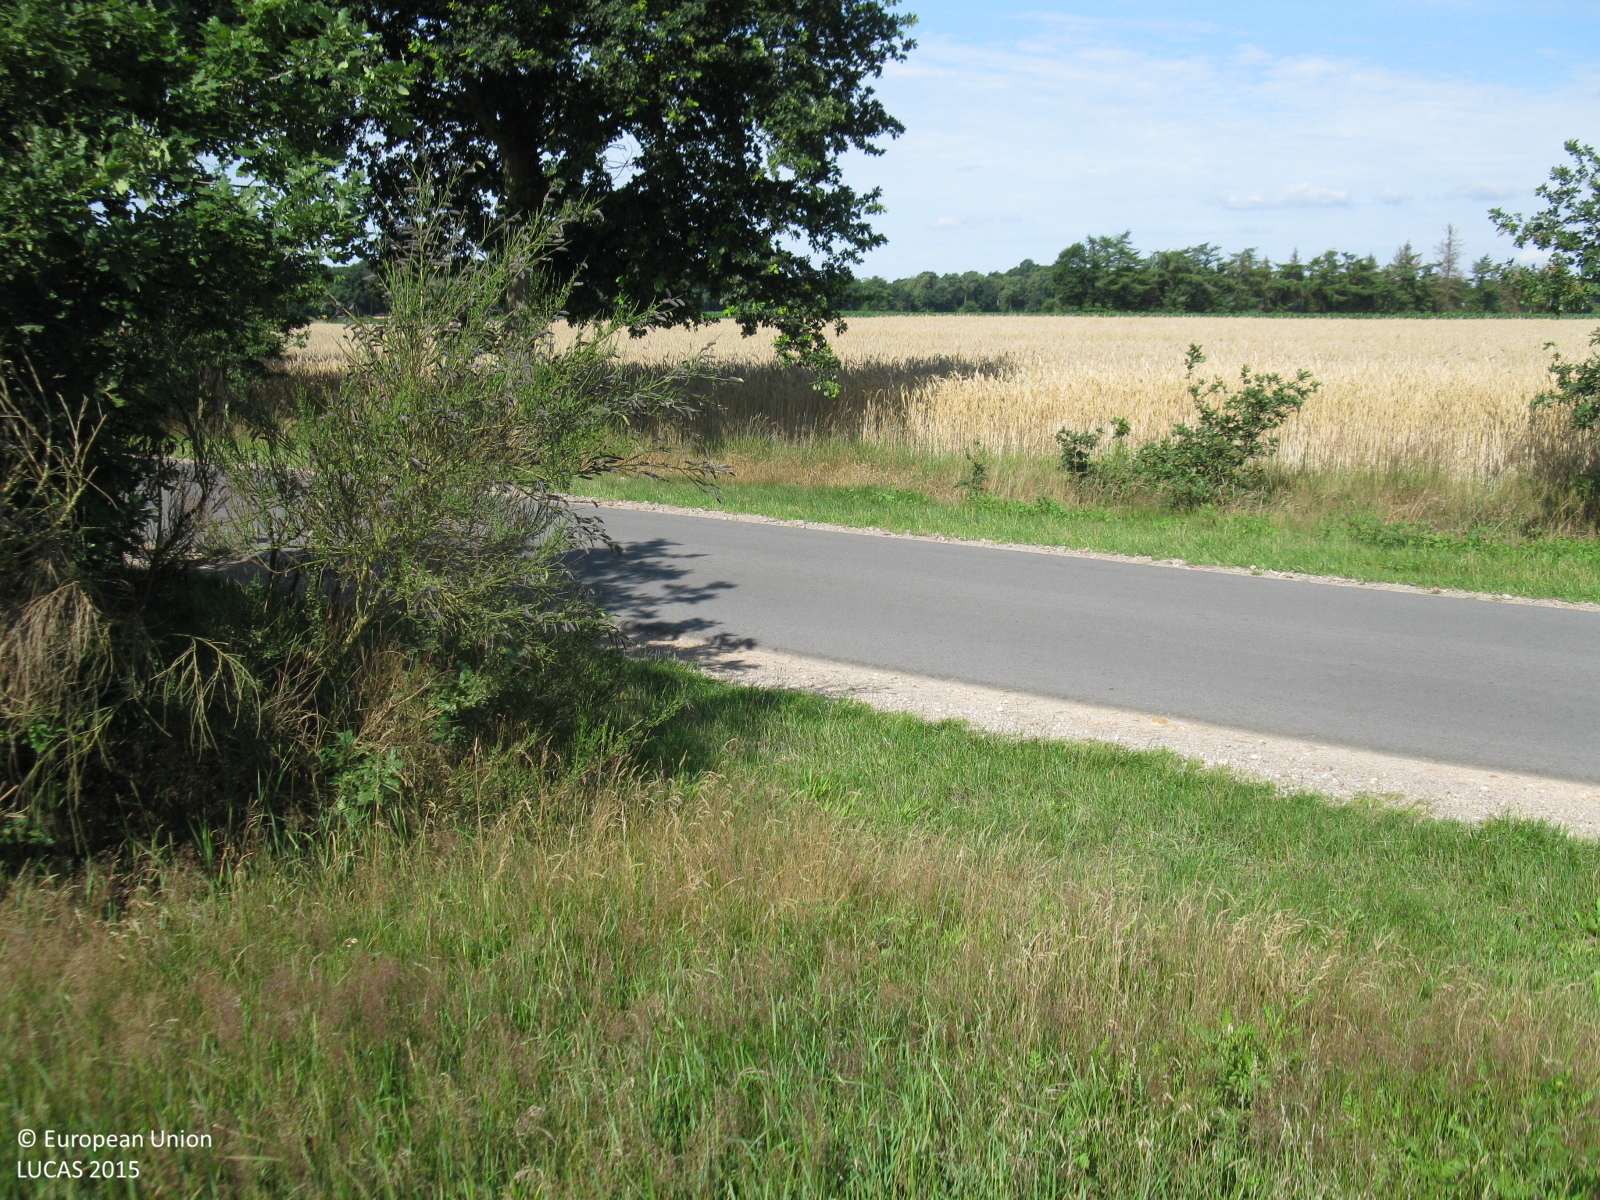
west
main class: Cropland
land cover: Triticale
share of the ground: > 75 %
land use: Agriculture (excluding fallow land and kitchen gardens)
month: July
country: DE
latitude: 52.9882
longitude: 7.9002
